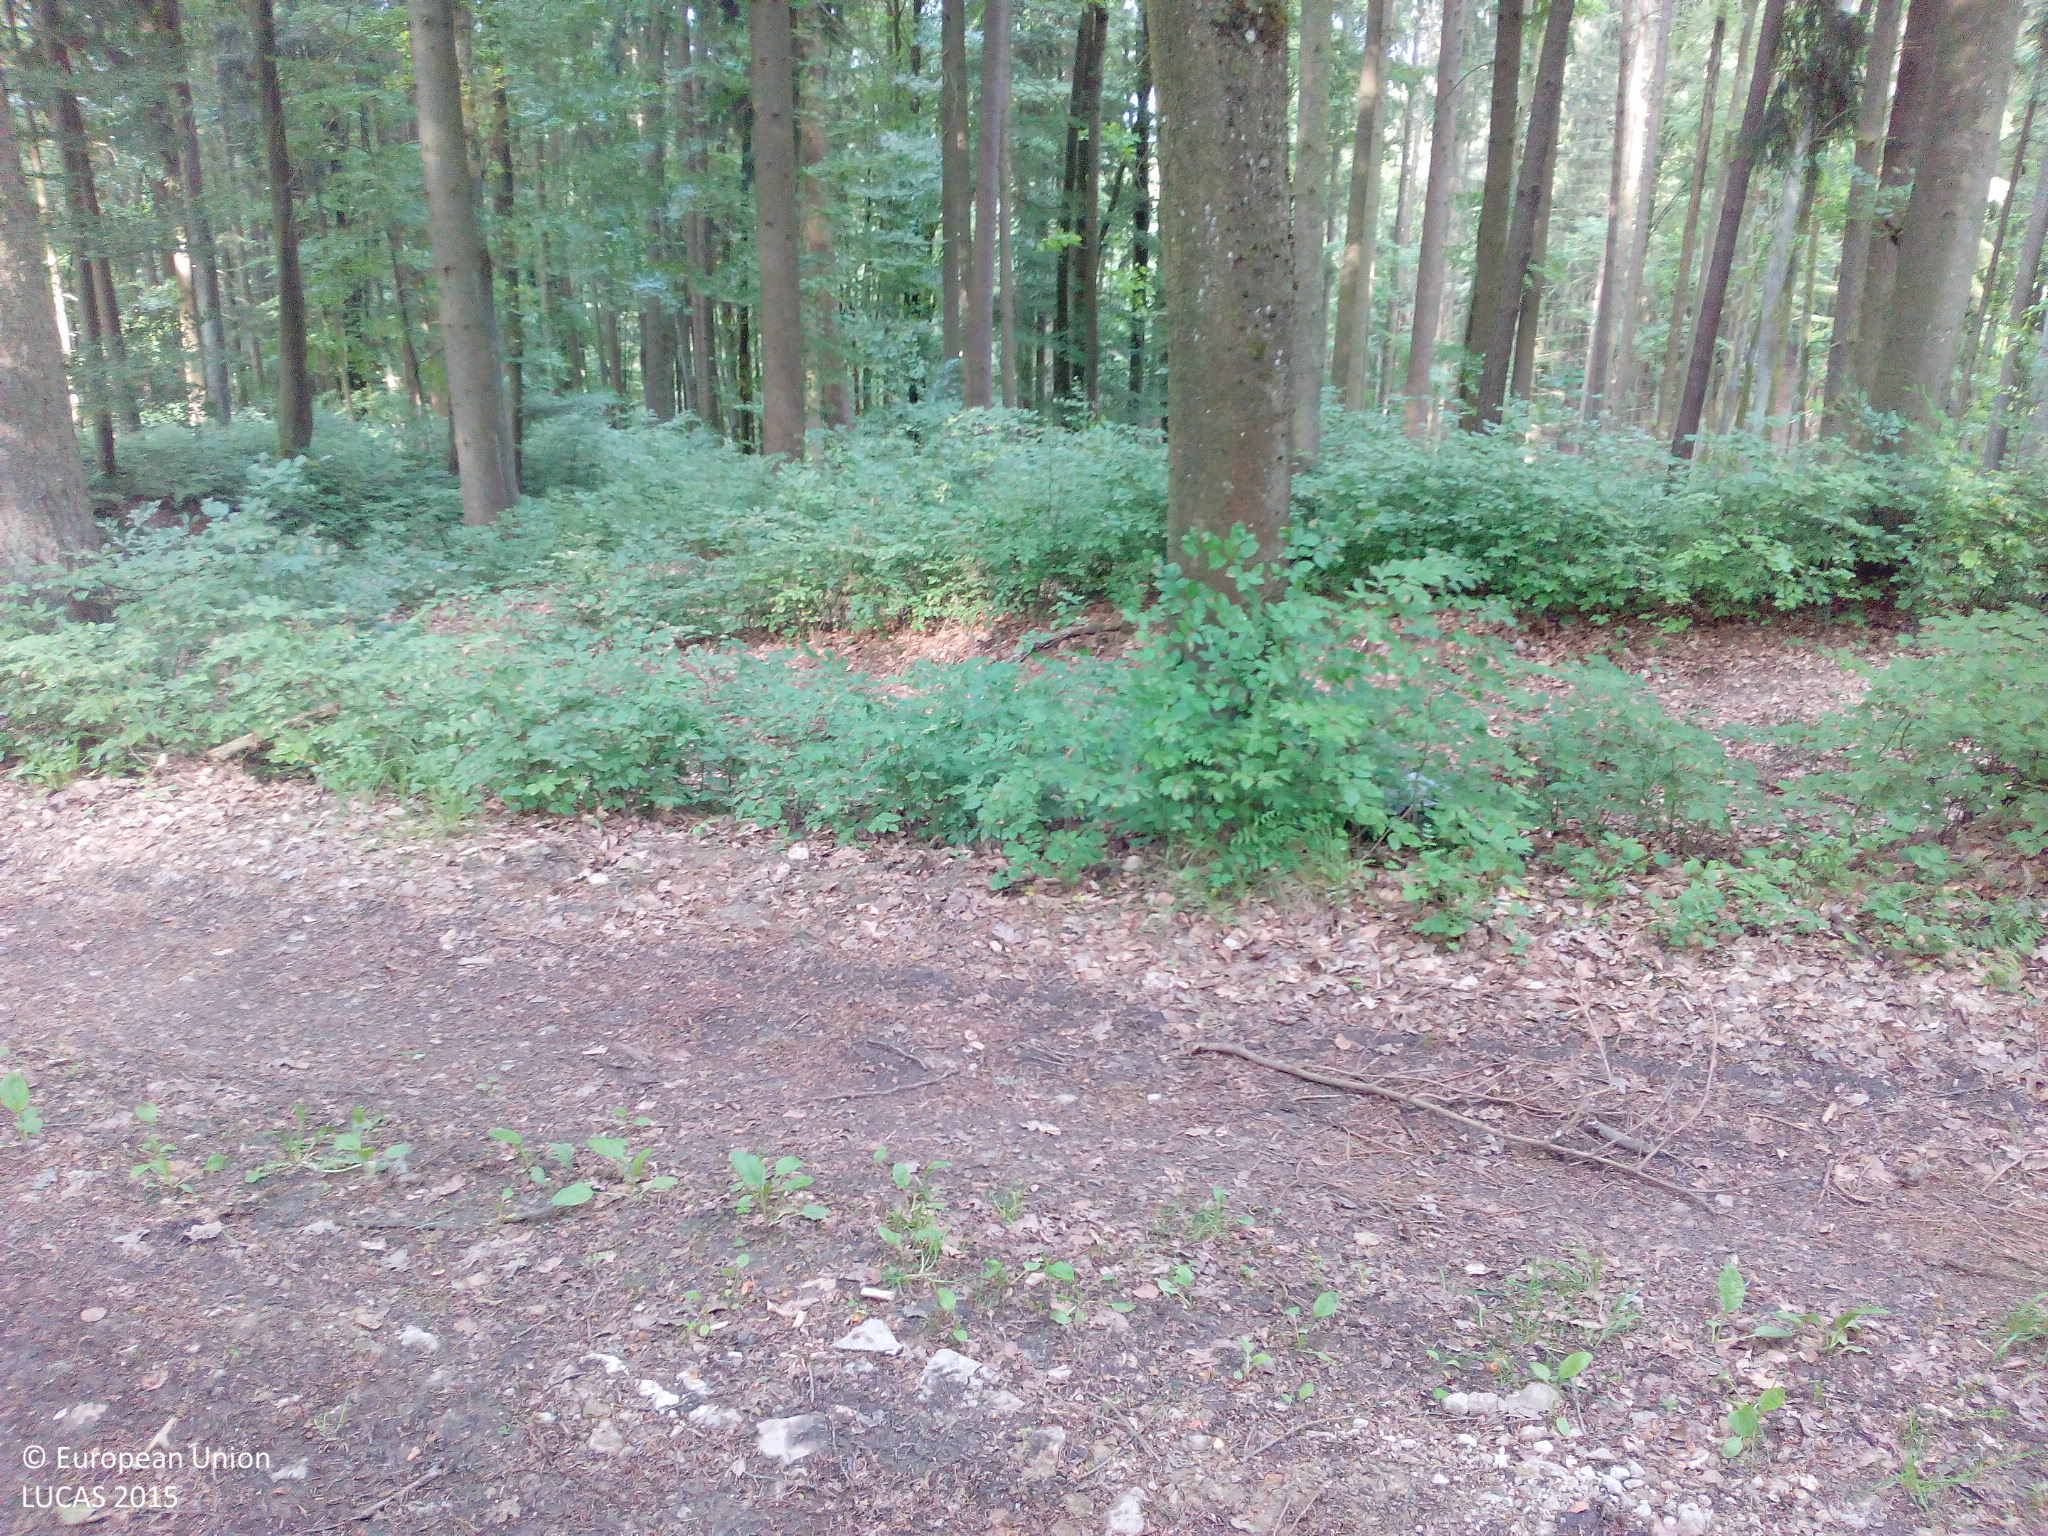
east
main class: Woodland
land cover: Spruce dominated mixed woodland
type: hemiboreal forest and nemoral coniferous forest and mixed broadleaved-coniferous forest
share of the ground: > 75 %
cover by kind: coniferous forest trees 50 %, broadleaved forest trees 30 %, unconsolidated bare surface 15 %, shrubs 5 %
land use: Forestry
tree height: > 5 m
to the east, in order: Spruce dominated mixed woodland; Tracks; Spruce dominated mixed woodland; Other mixed woodland; Tracks; Other mixed woodland
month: May
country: DE
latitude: 49.1784
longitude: 11.9337
